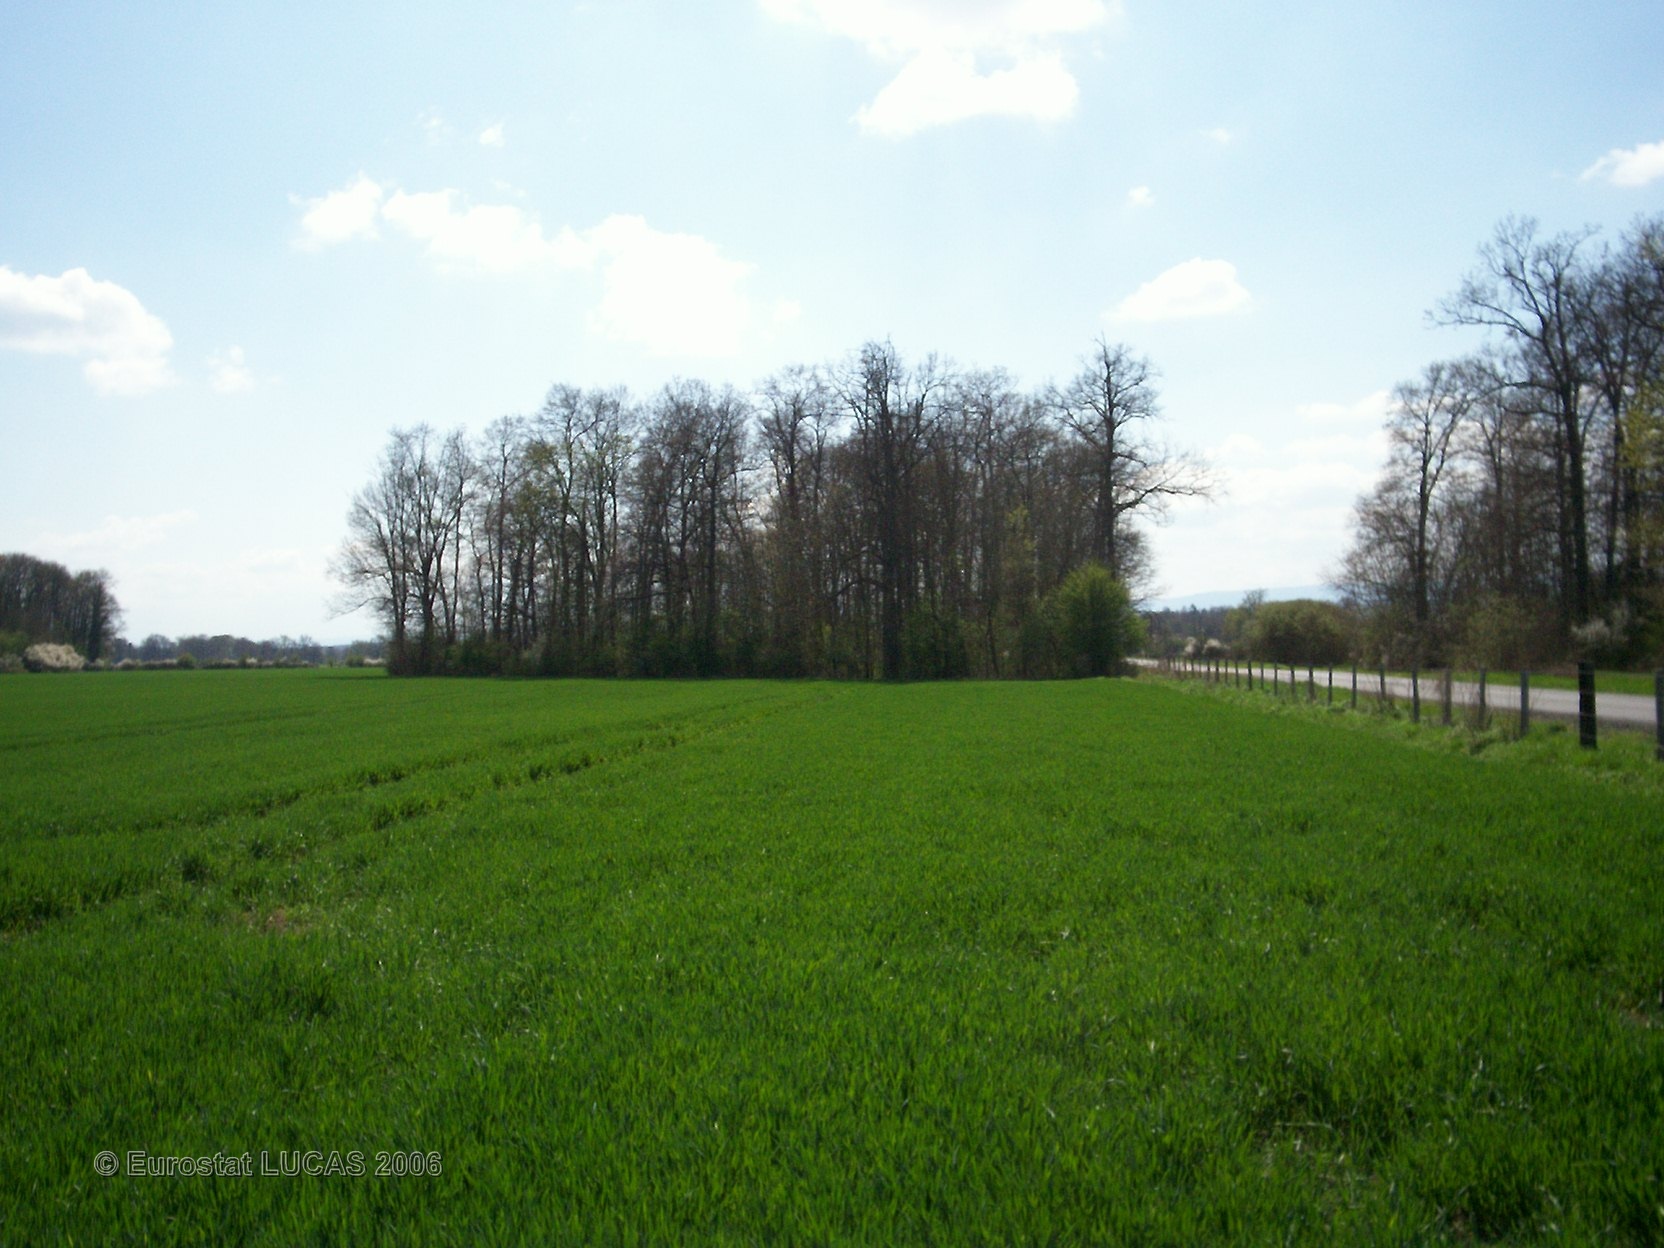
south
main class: Cropland
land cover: Common wheat
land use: Agriculture (excluding fallow land and kitchen gardens)
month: April
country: FR
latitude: 45.7054
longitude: 4.1842
